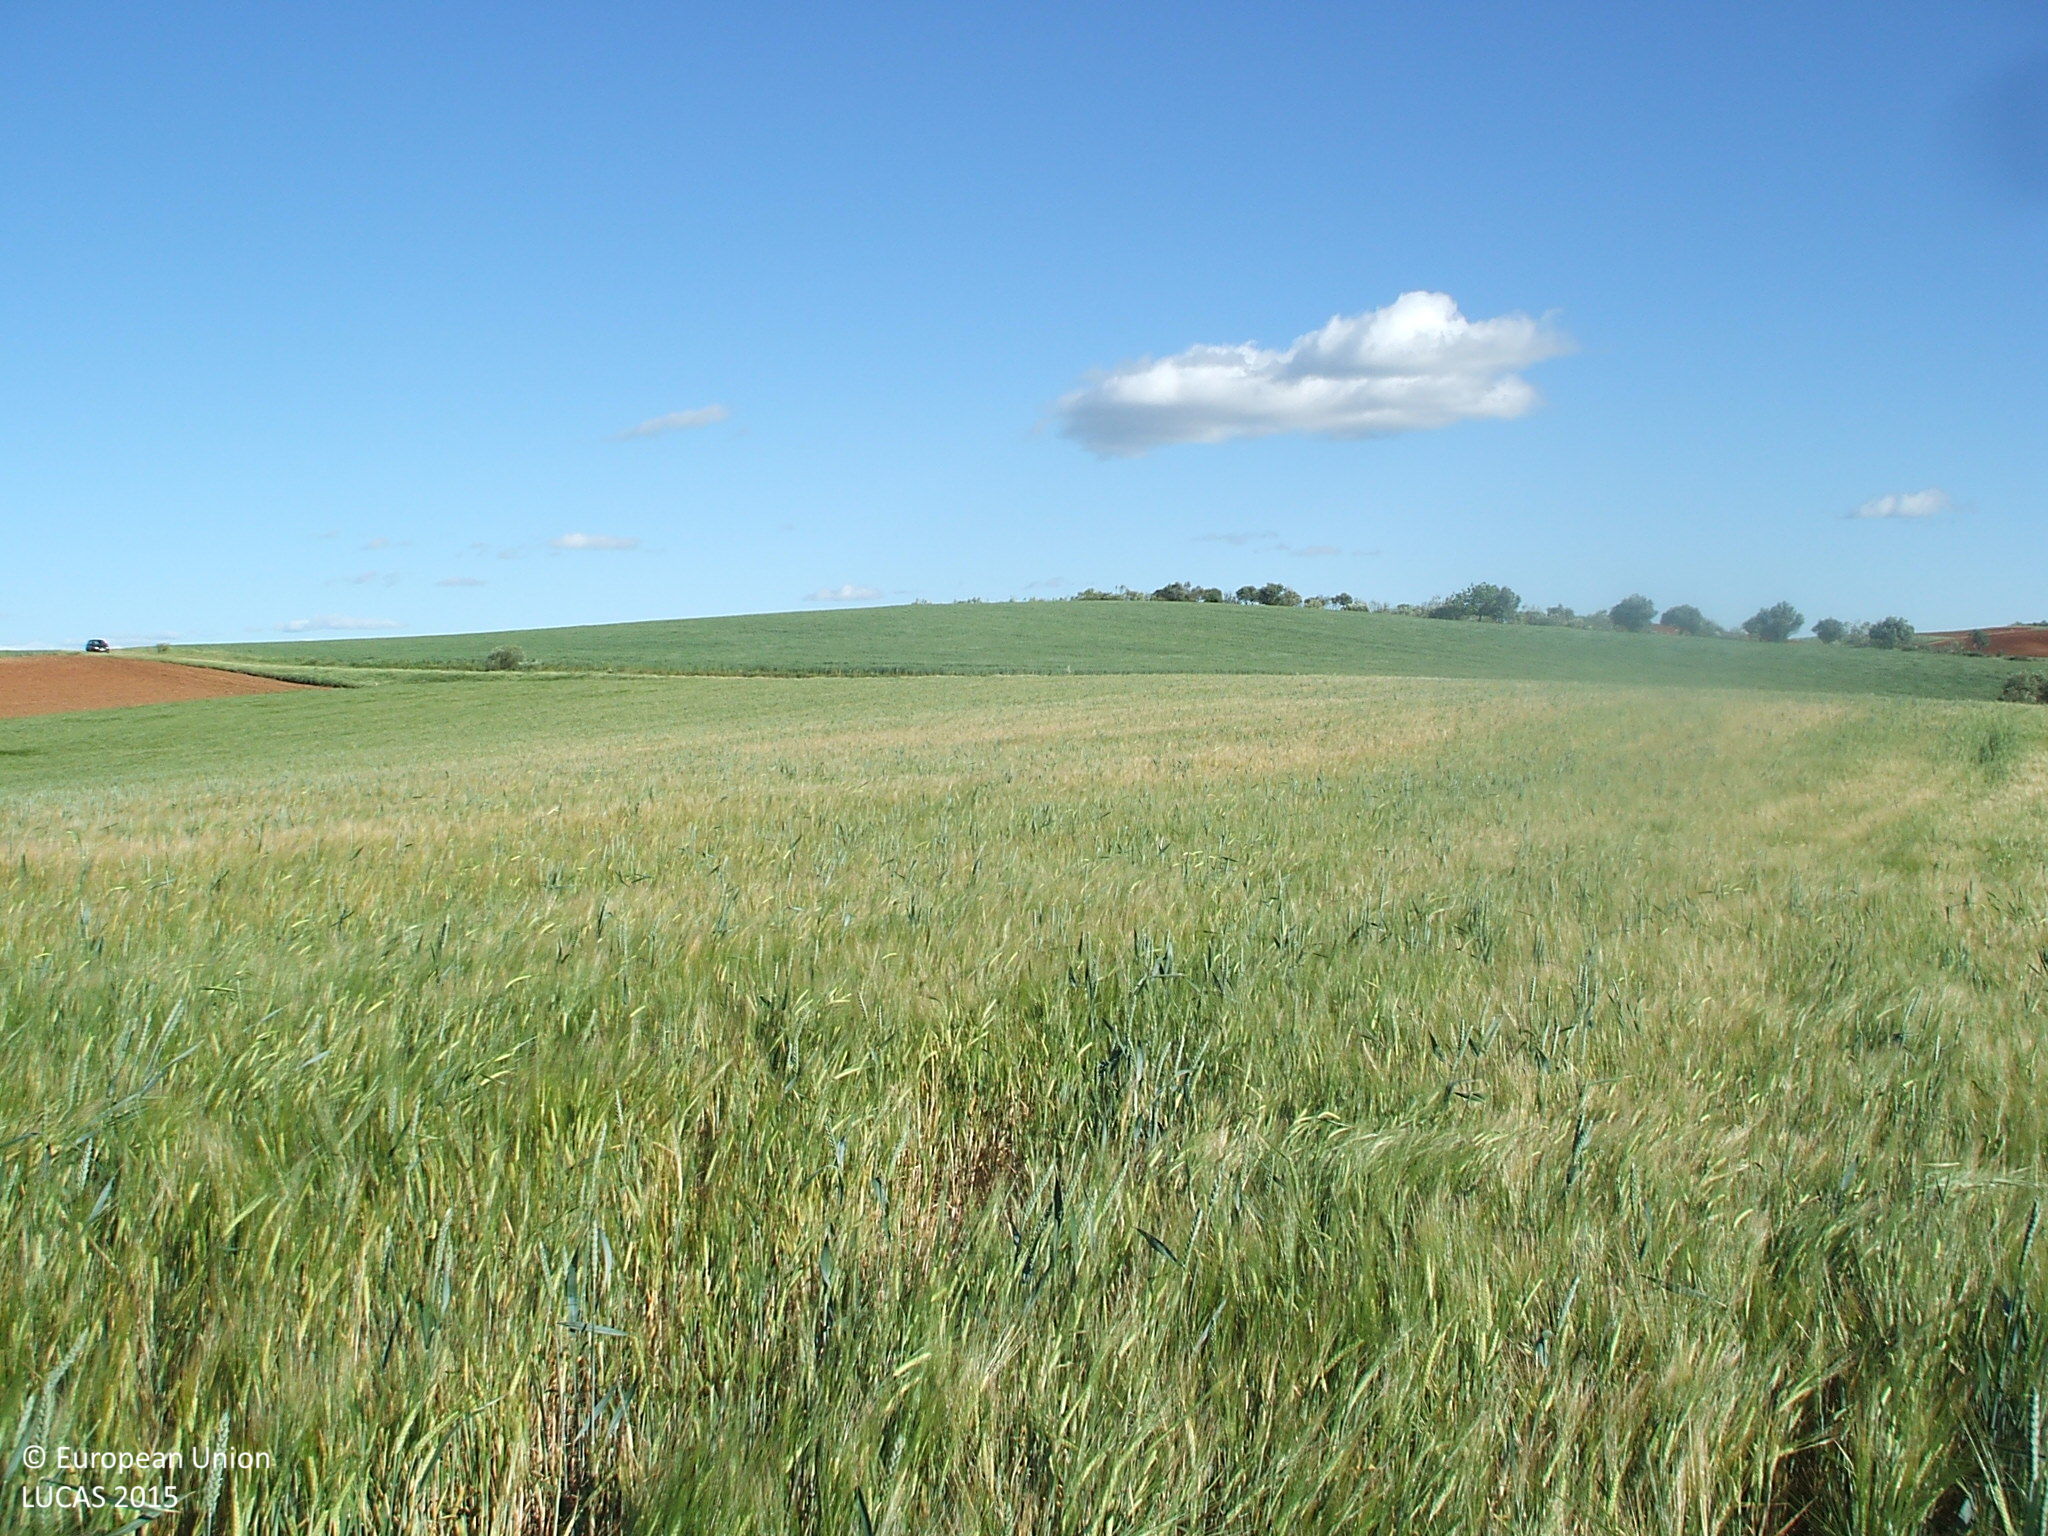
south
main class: Cropland
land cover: Mixed cereals for fodder
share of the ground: > 75 %
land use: Agriculture (excluding fallow land and kitchen gardens)
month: May
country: ES
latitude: 40.8702
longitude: -3.0751
